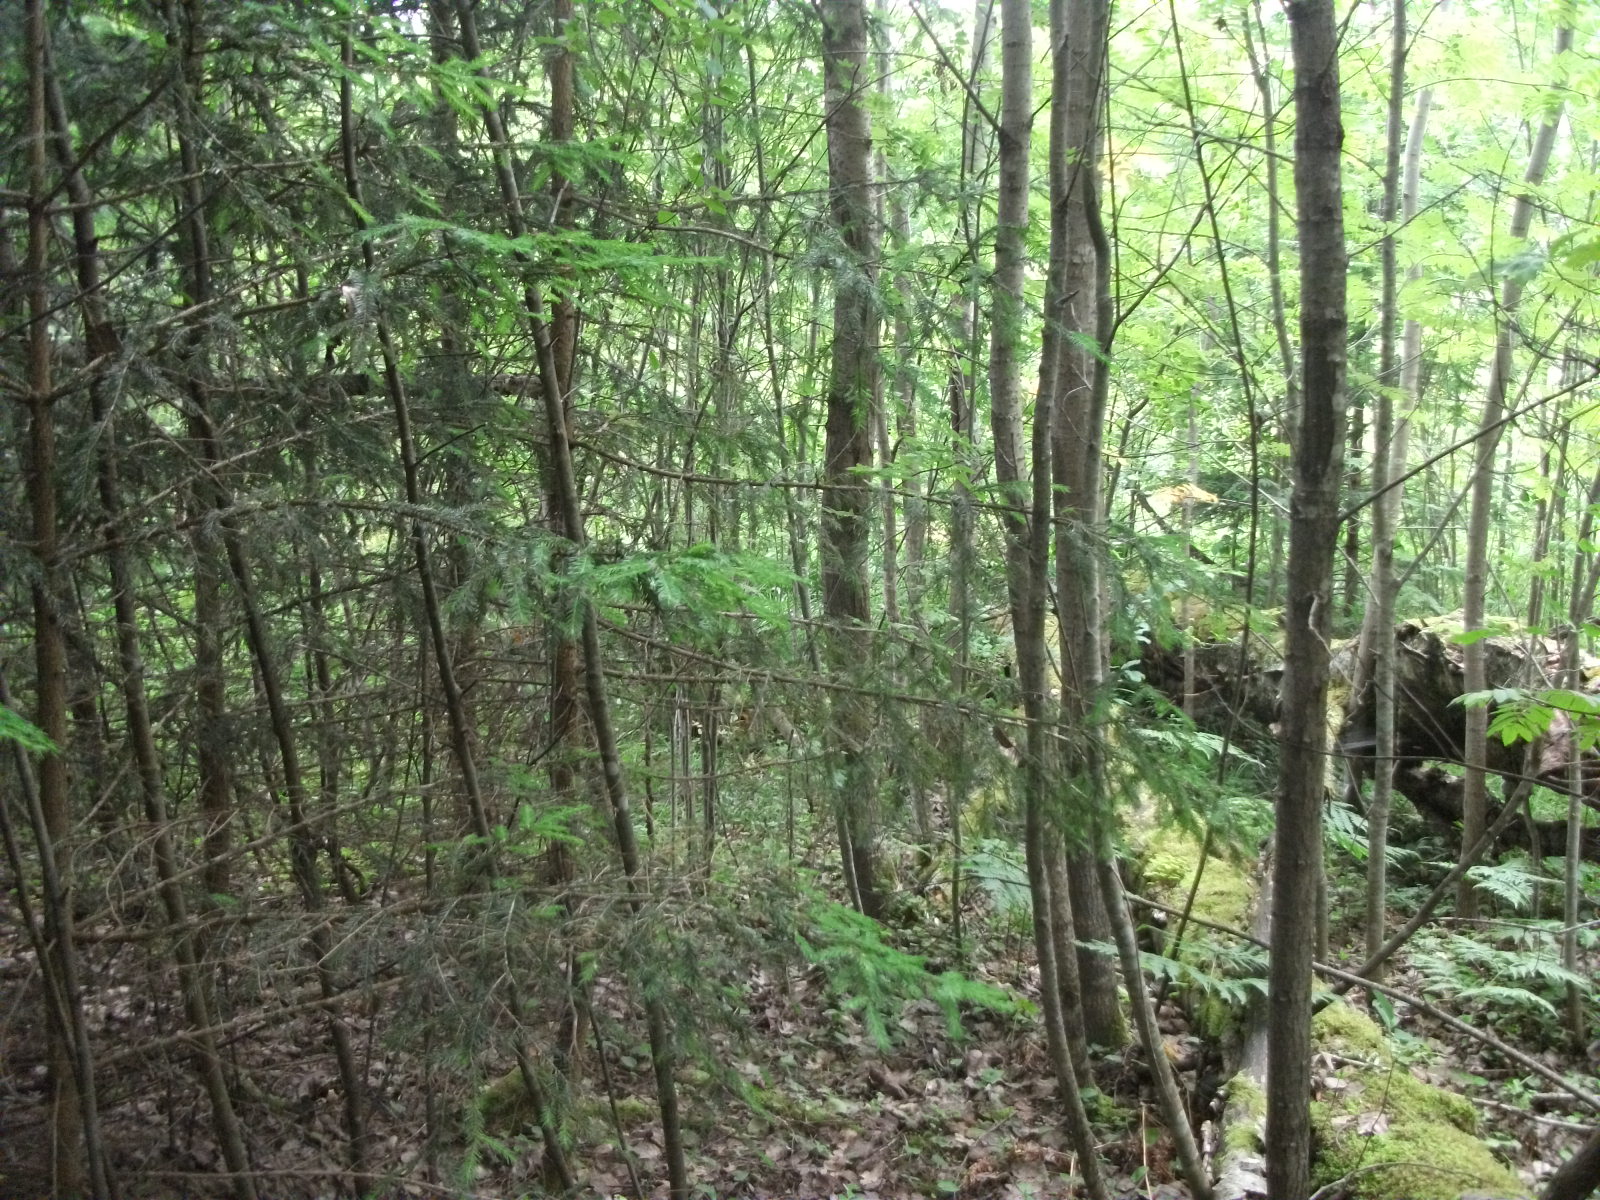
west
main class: Woodland
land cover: Spruce dominated coniferous woodland
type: hemiboreal forest and nemoral coniferous forest and mixed broadleaved-coniferous forest
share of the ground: > 75 %
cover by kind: coniferous forest trees 90 %, herbaceous plants 5 %, unconsolidated bare surface 5 %
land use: Forestry
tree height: > 5 m
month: July
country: LV
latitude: 57.1833
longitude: 26.5408
